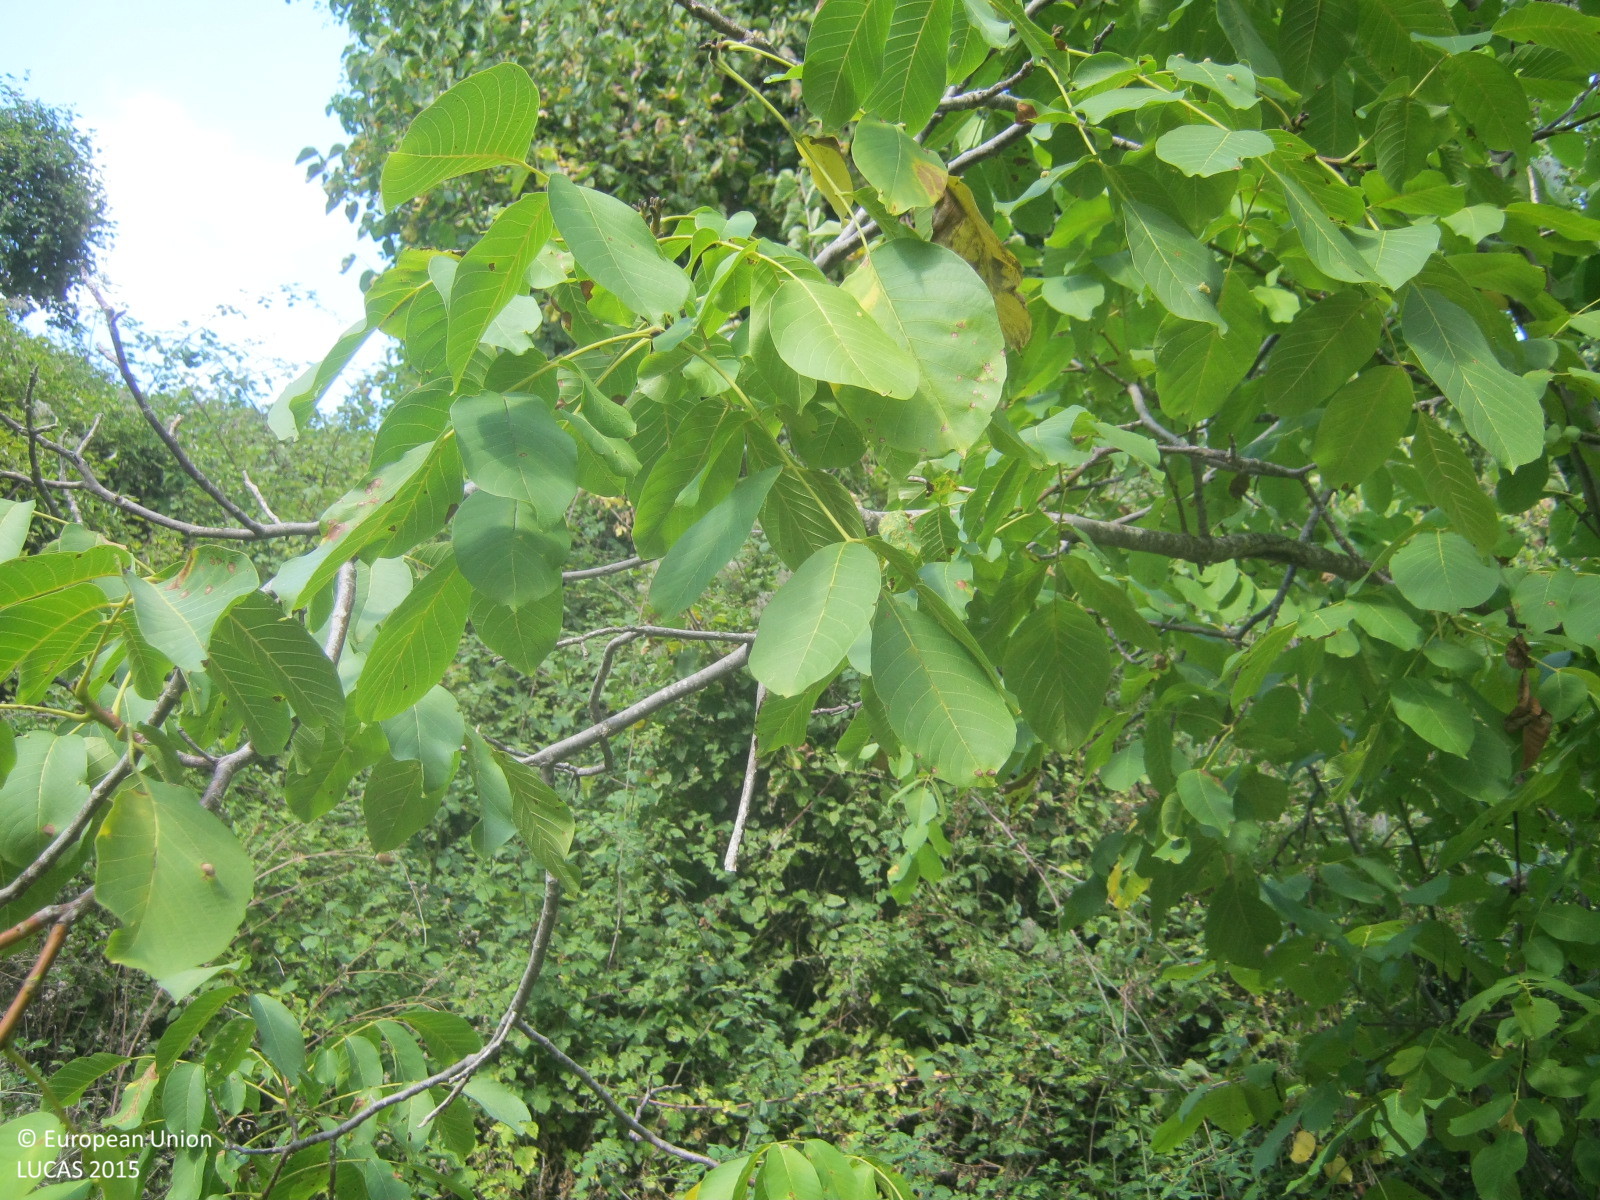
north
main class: Cropland
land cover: Nuts trees
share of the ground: 25 - 50 %
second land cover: Spontaneously vegetated surfaces
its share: > 75 %
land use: Agriculture (excluding fallow land and kitchen gardens)
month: September
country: GR
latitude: 38.1026
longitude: 22.1362
